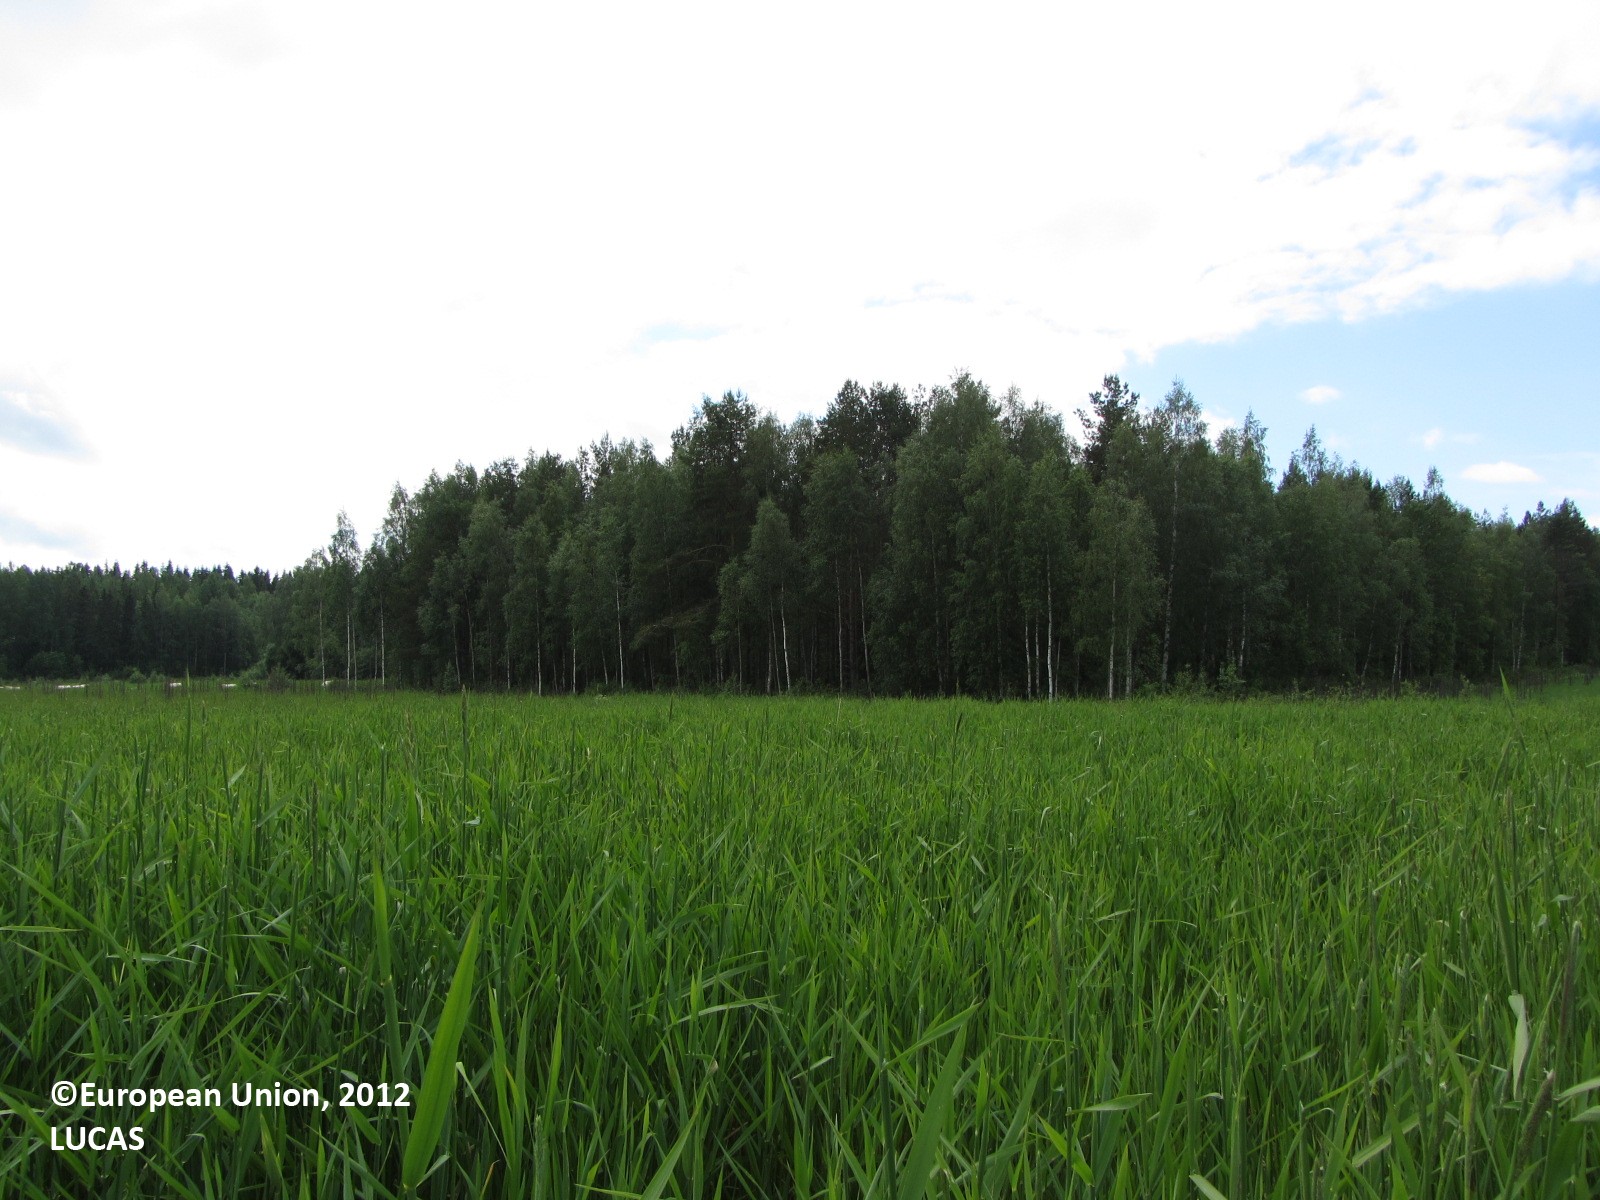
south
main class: Cropland
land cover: Temporary grasslands
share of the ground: > 75 %
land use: Agriculture (excluding fallow land and kitchen gardens)
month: July
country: FI
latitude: 62.8978
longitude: 25.0706
